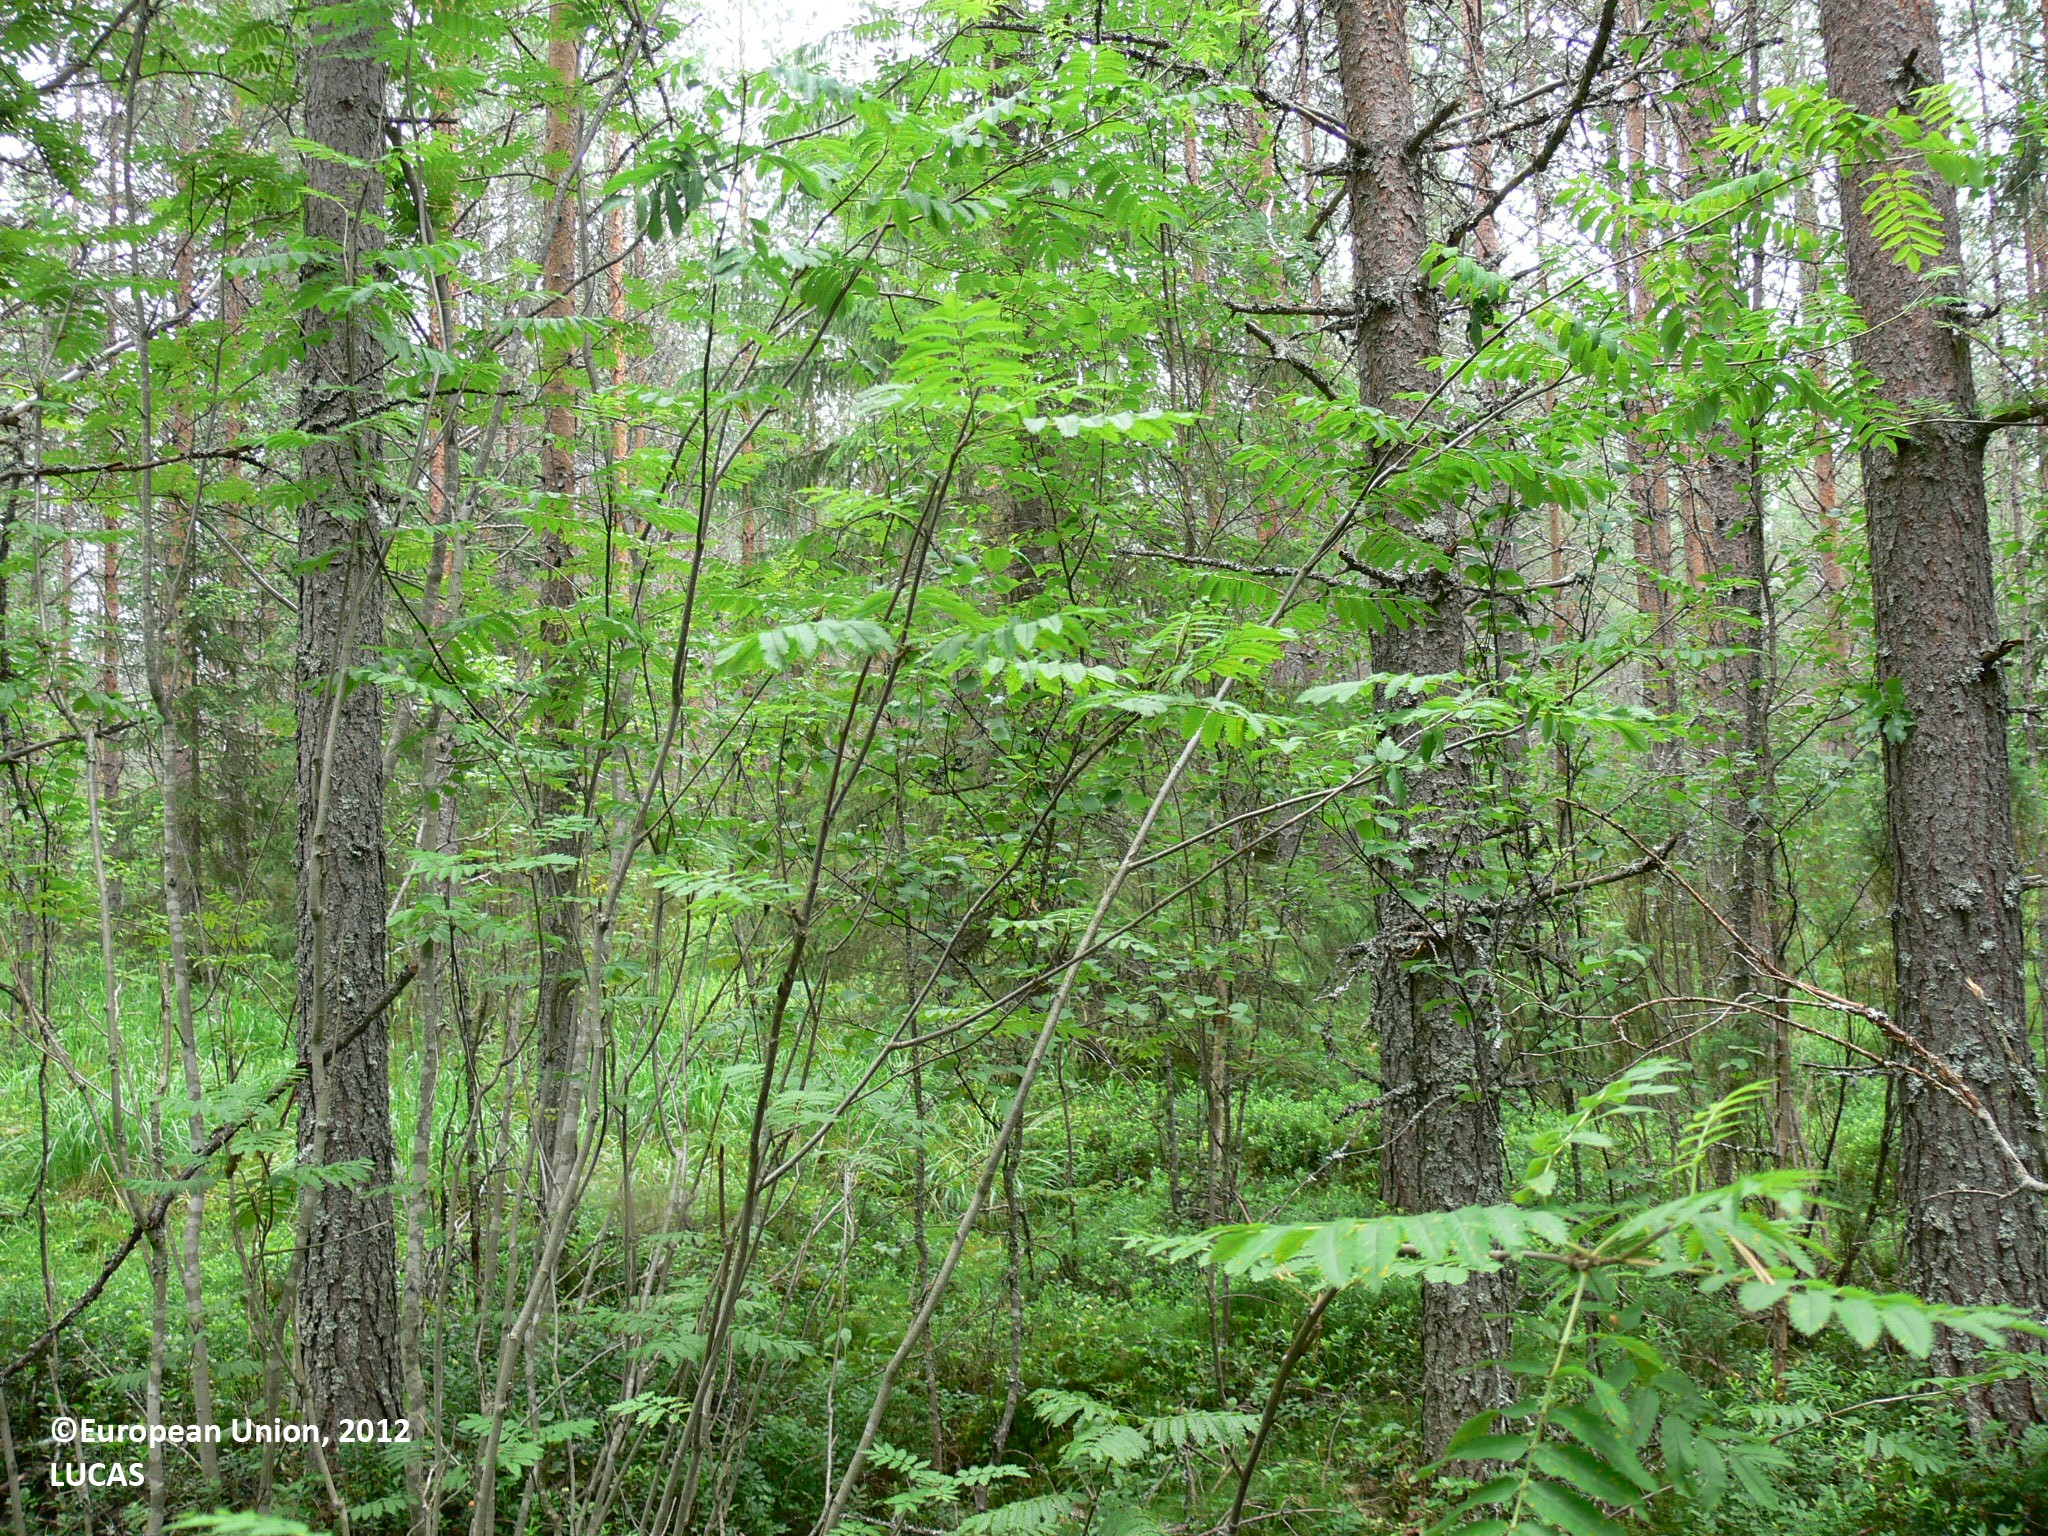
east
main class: Woodland
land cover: Other mixed woodland
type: boreal forest
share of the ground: > 75 %
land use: Forestry
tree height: > 5 m
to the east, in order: Other mixed woodland; Pine dominated coniferous woodland; Ditches and canals; Pine dominated coniferous woodland; Ditches and canals; Pine dominated coniferous woodland
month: July
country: FI
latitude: 63.2288
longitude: 30.7202
